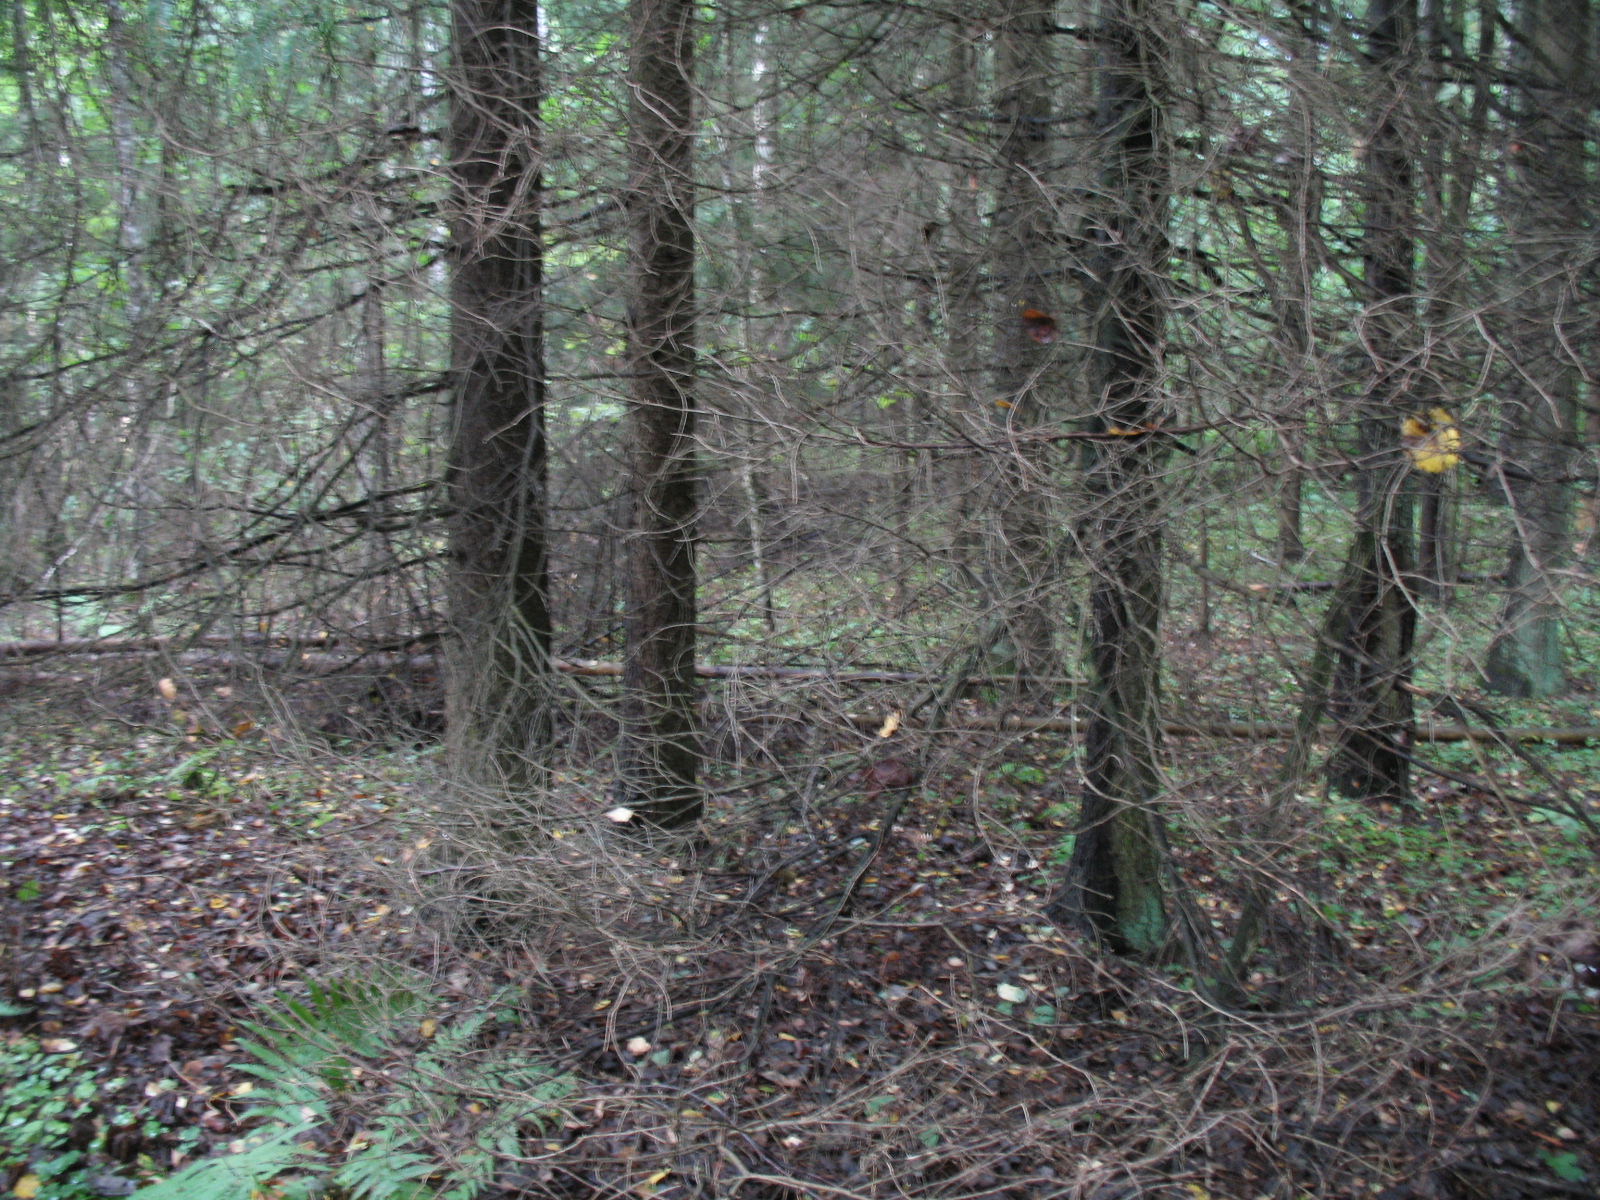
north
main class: Woodland
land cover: Spruce dominated mixed woodland
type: hemiboreal forest and nemoral coniferous forest and mixed broadleaved-coniferous forest
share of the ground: > 75 %
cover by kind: broadleaved forest trees 45 %, coniferous forest trees 40 %, herbaceous plants 10 %, unconsolidated bare surface 5 %
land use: Forestry
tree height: > 5 m
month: September
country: LV
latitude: 56.1047
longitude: 25.9056
